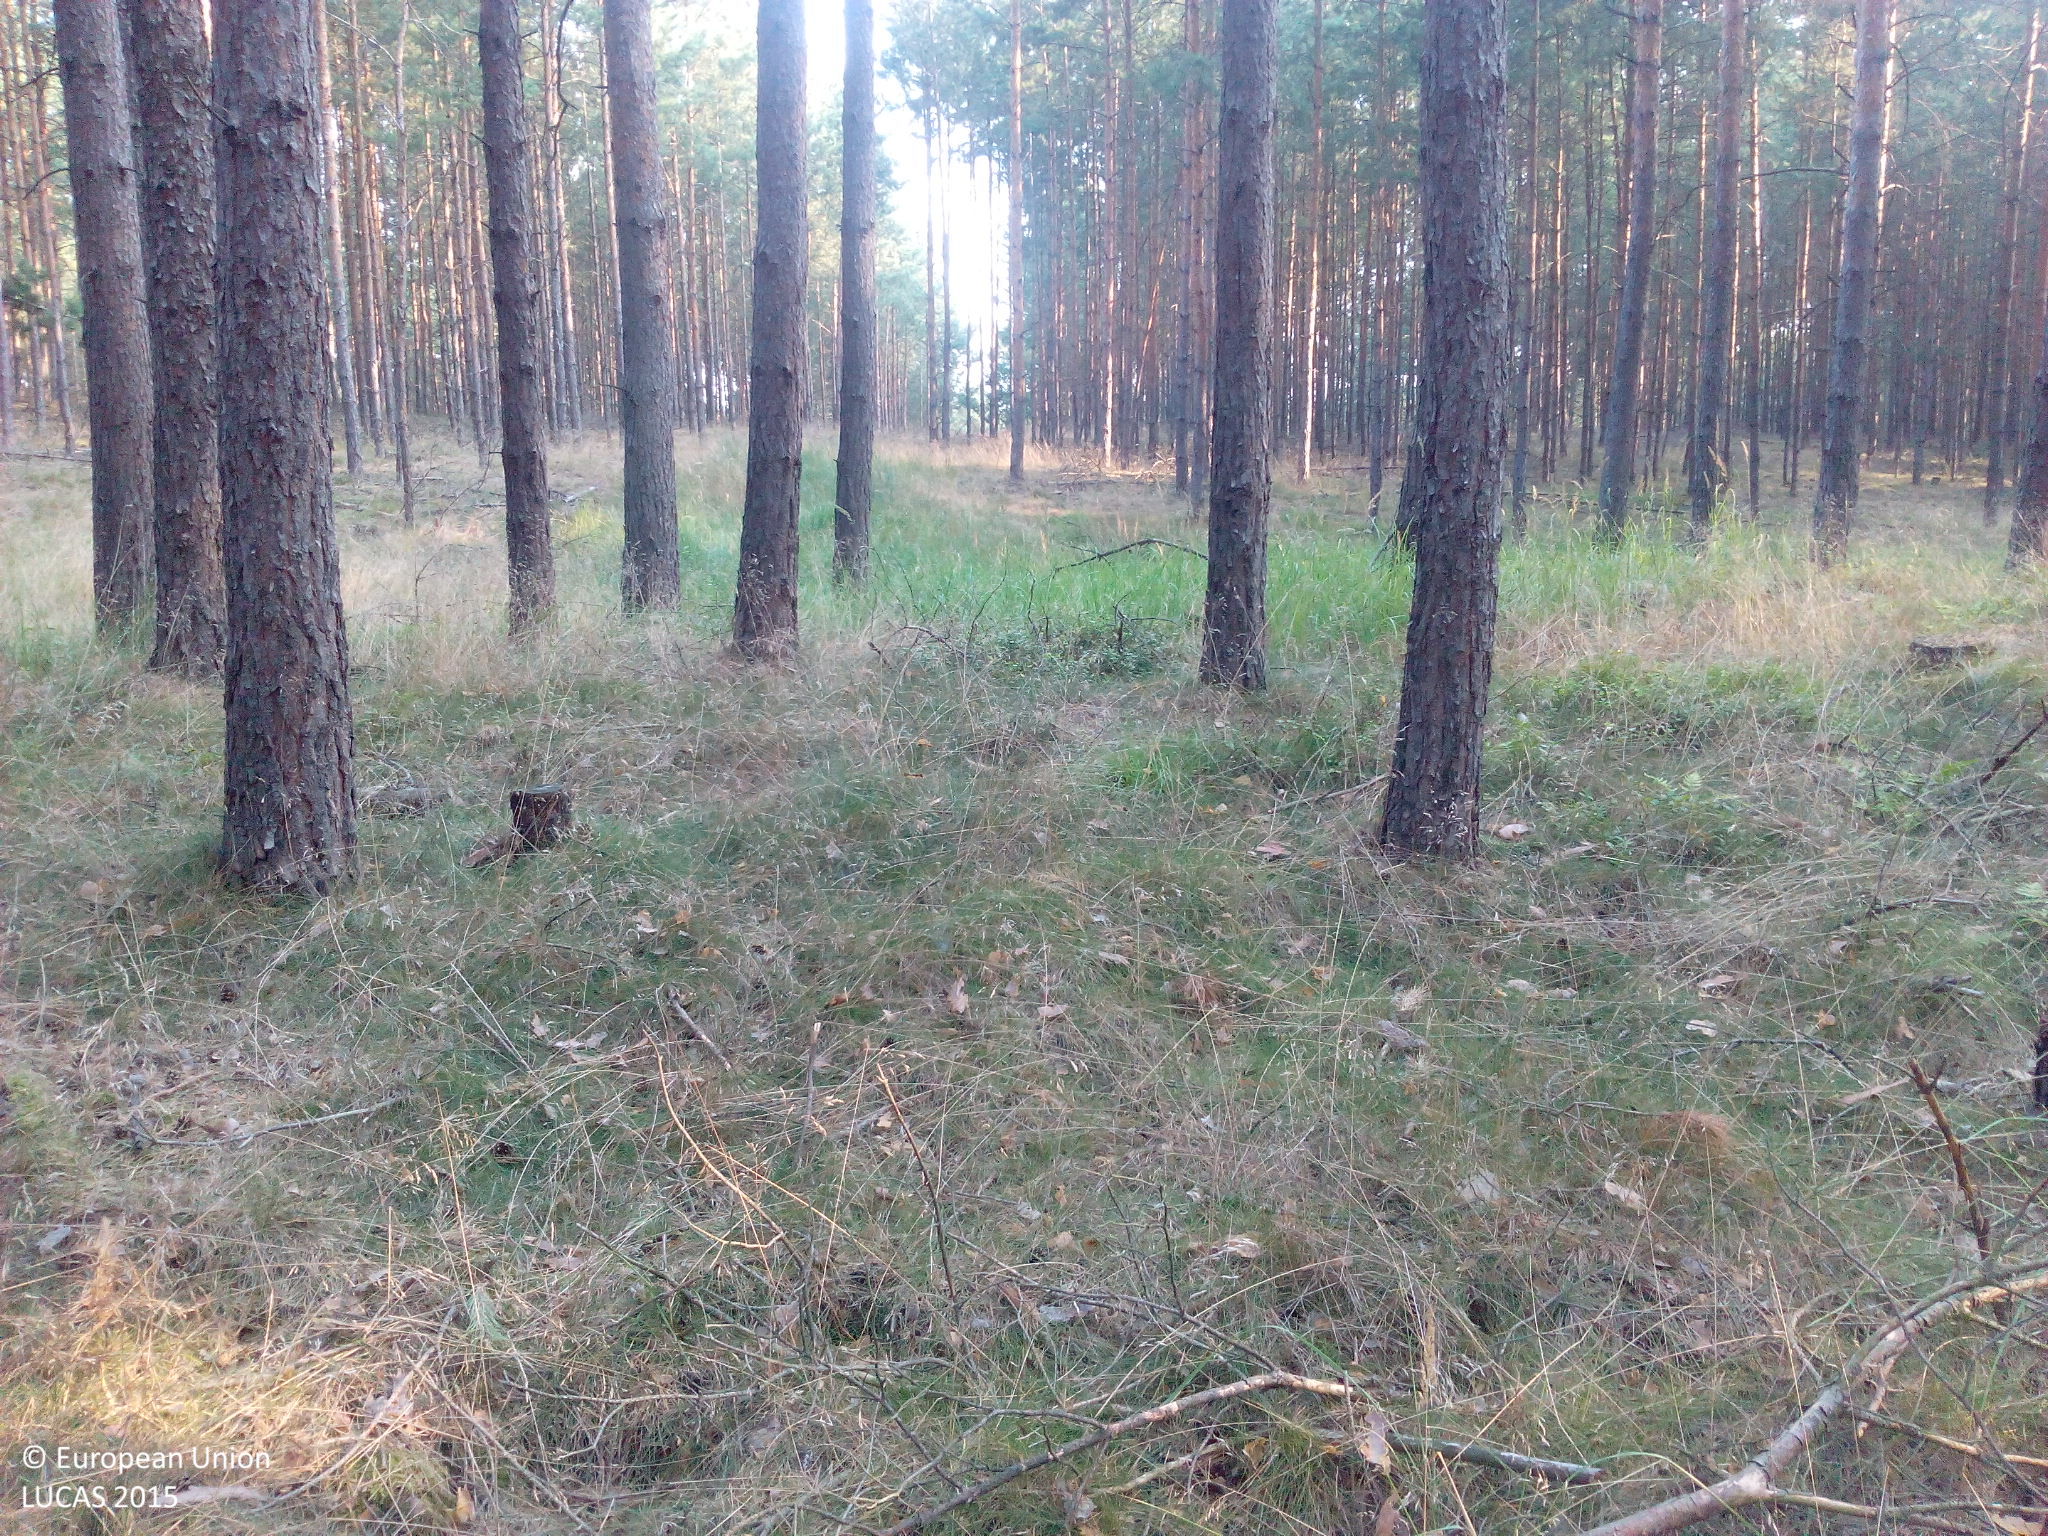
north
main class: Woodland
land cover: Pine dominated coniferous woodland
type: hemiboreal forest and nemoral coniferous forest and mixed broadleaved-coniferous forest
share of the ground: > 75 %
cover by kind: coniferous forest trees 95 %, herbaceous plants 5 %
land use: Forestry
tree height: > 5 m
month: August
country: DE
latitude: 51.6795
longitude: 13.4569
